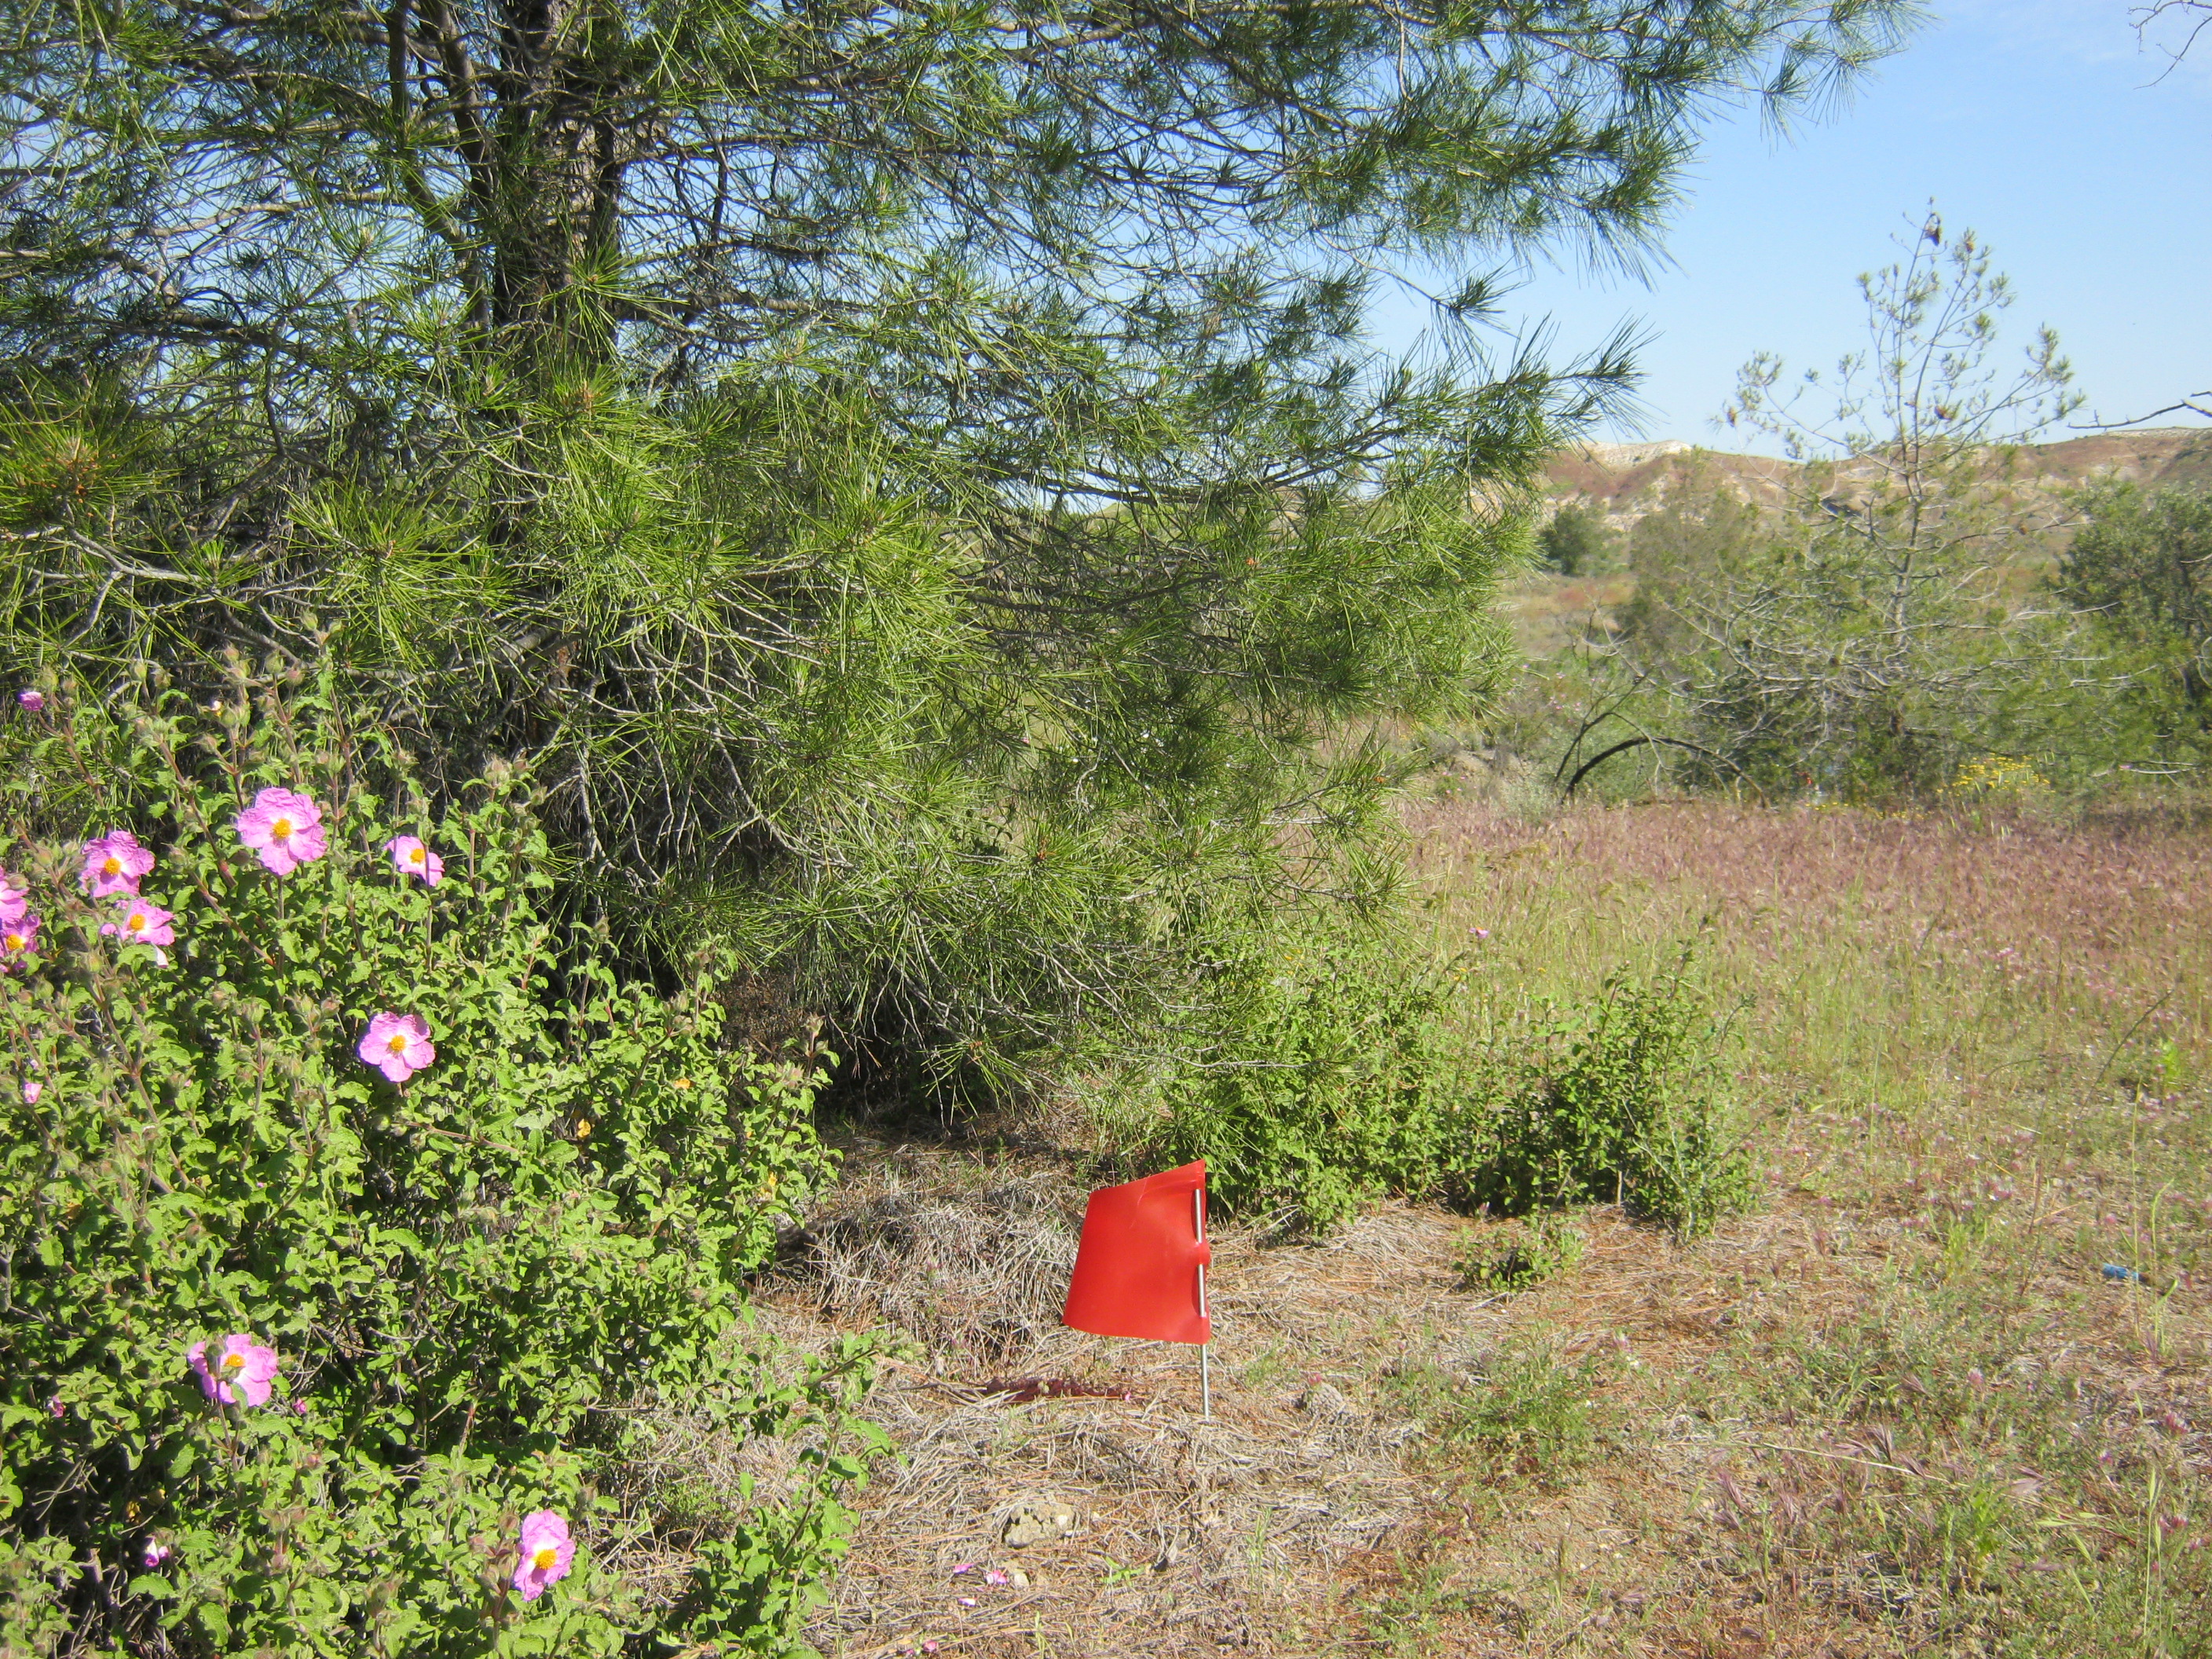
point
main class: Woodland
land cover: Pine dominated coniferous woodland
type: coniferous forest of the mediterranean region
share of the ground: 25 - 50 %
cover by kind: herbaceous plants 65 %, coniferous forest trees 25 %, broadleaved forest trees 5 %, unconsolidated bare surface 5 %
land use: Semi-natural and natural areas not in use
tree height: > 5 m
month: April
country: CY
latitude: 34.9826
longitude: 33.2876
